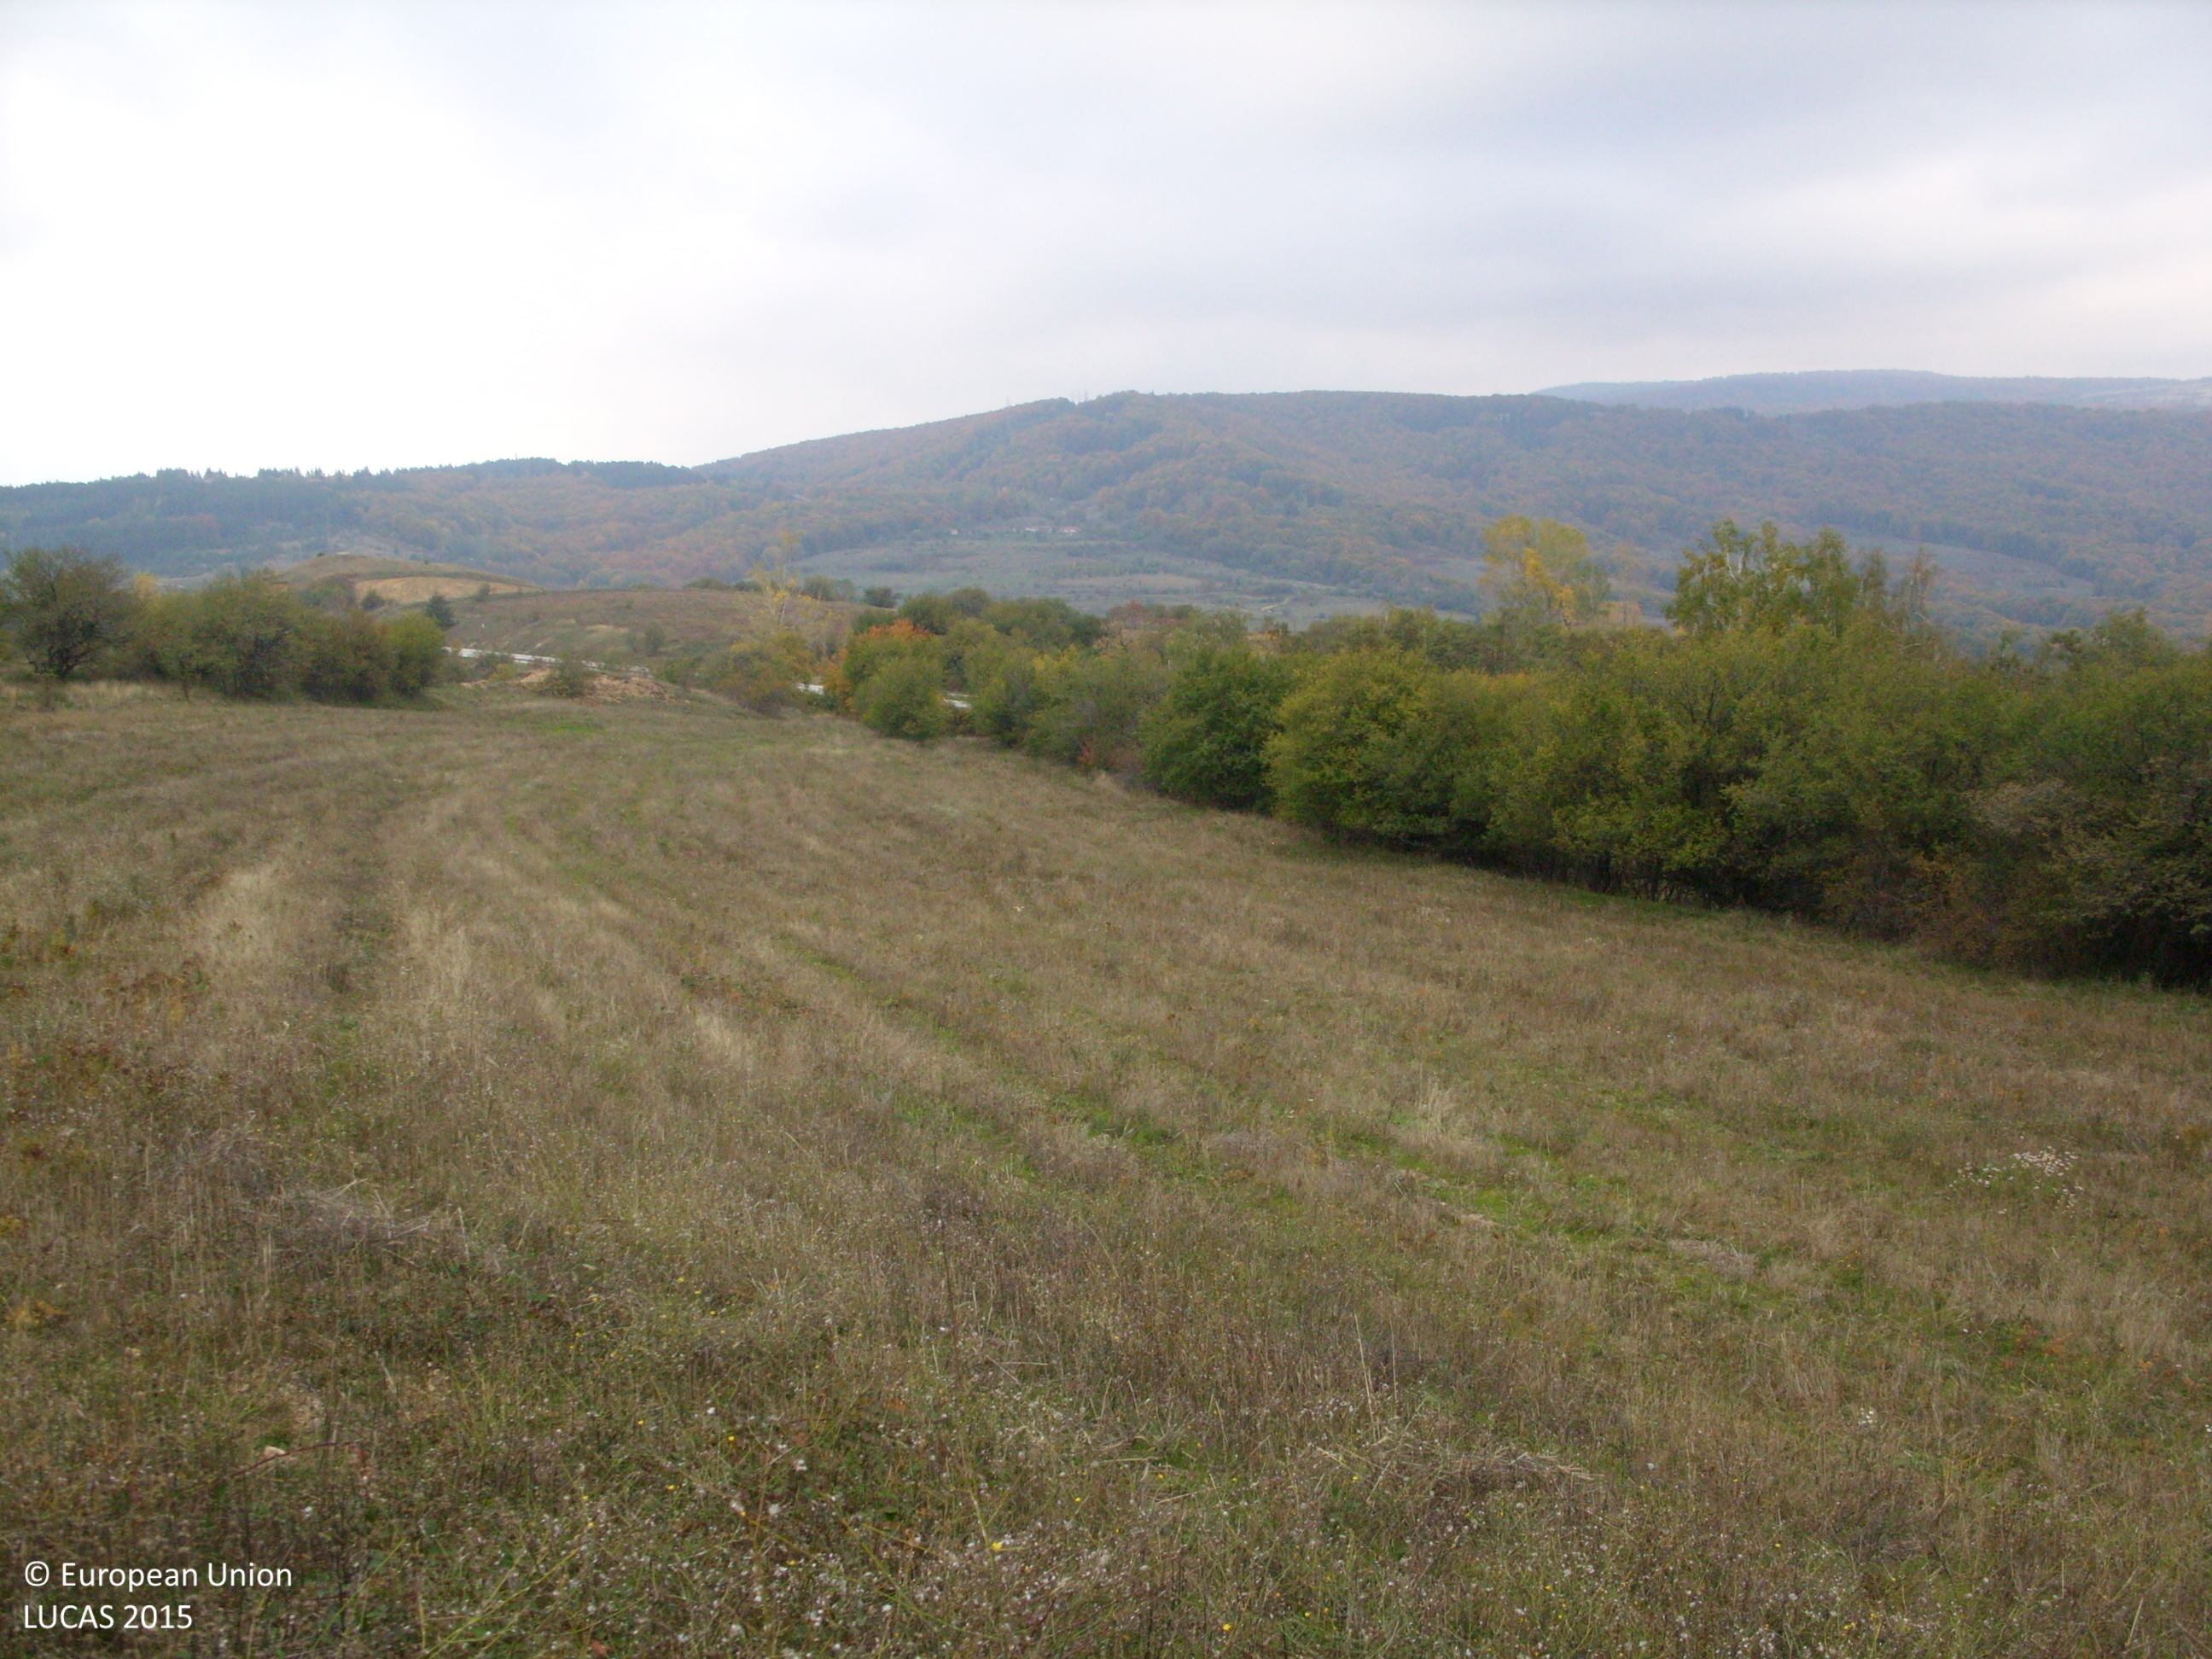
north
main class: Grassland
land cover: Spontaneously vegetated surfaces
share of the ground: > 75 %
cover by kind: herbaceous plants 100 %
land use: Agriculture (excluding fallow land and kitchen gardens)
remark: Harvested field
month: October
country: BG
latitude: 42.5613
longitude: 24.2126
